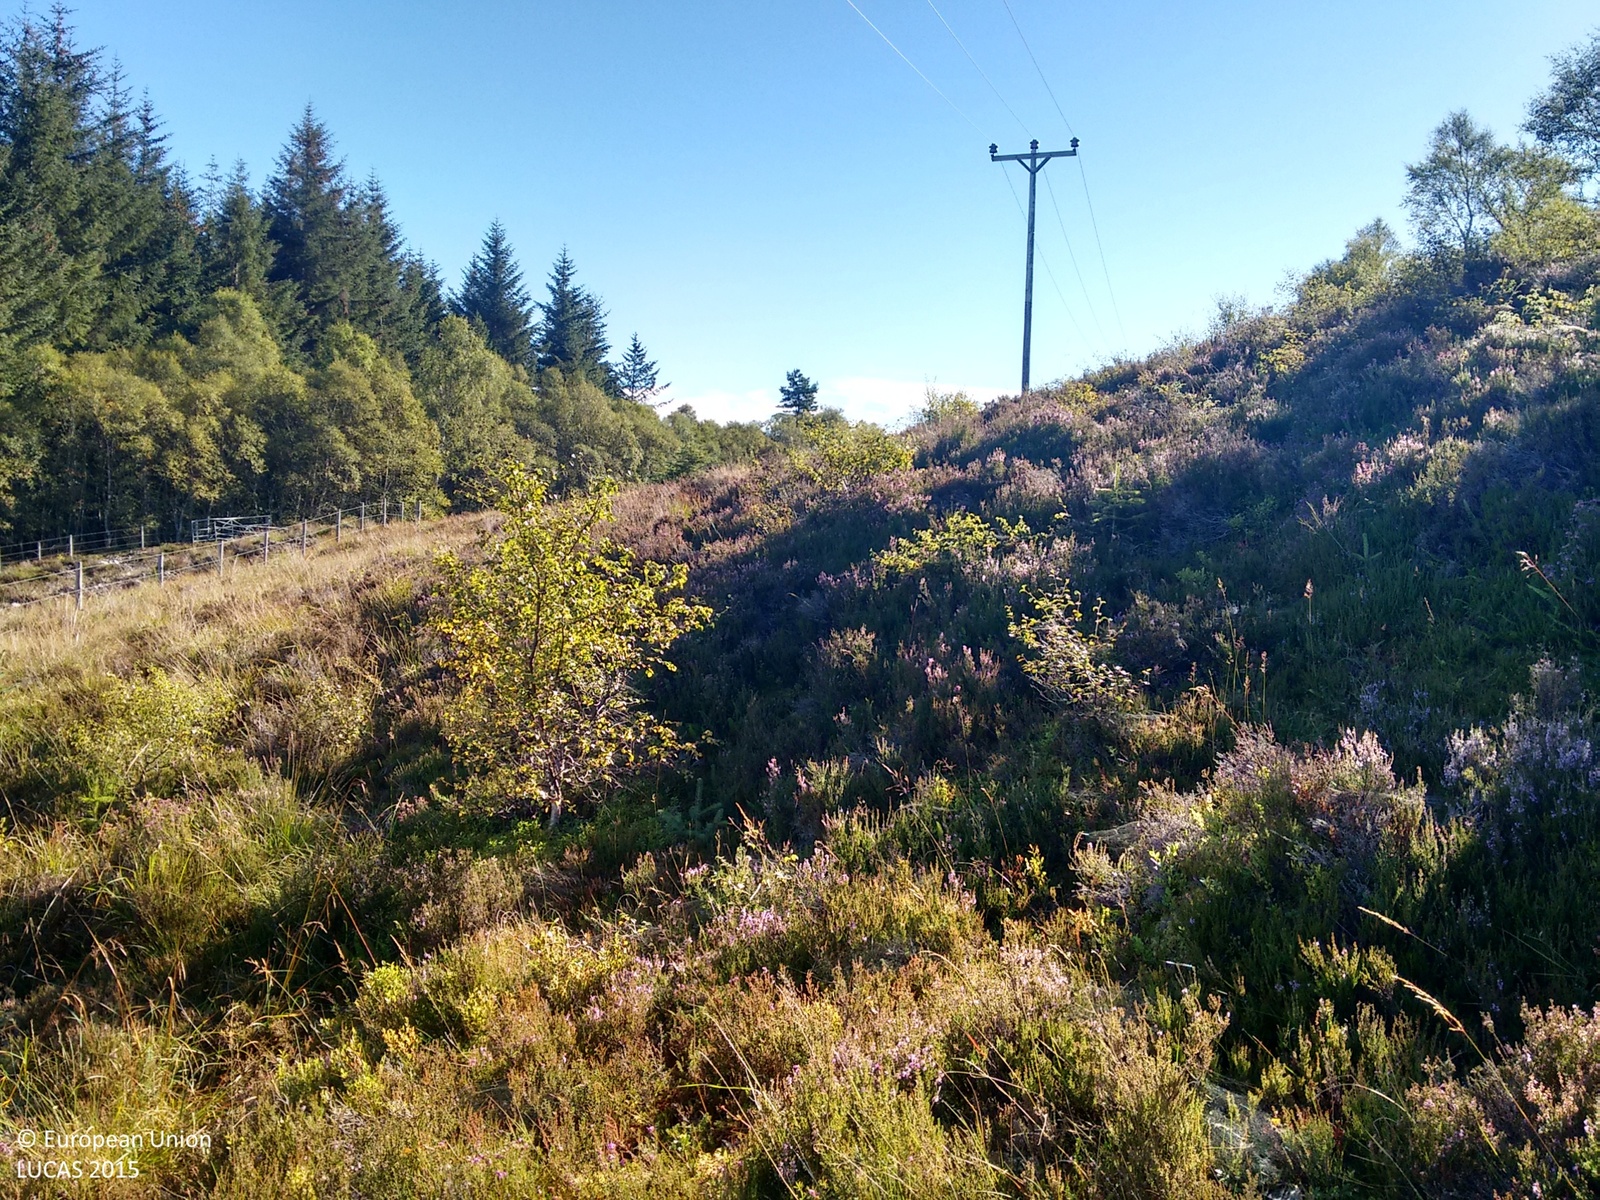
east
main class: Shrubland
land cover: Shrubland with sparse tree cover
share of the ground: > 75 %
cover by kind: shrubs 70 %, lichens and mosses 15 %, herbaceous plants 10 %, coniferous forest trees 5 %
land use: Forestry
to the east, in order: Shrubland with sparse tree cover; Electric lines; Shrubland with sparse tree cover; Tracks; Grass margins; Fences; Grass margins; Fences; Broadleaved woodland; Fences; Grassland without tree/shrub cover
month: September
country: GB
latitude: 57.7196
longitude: -4.3394
